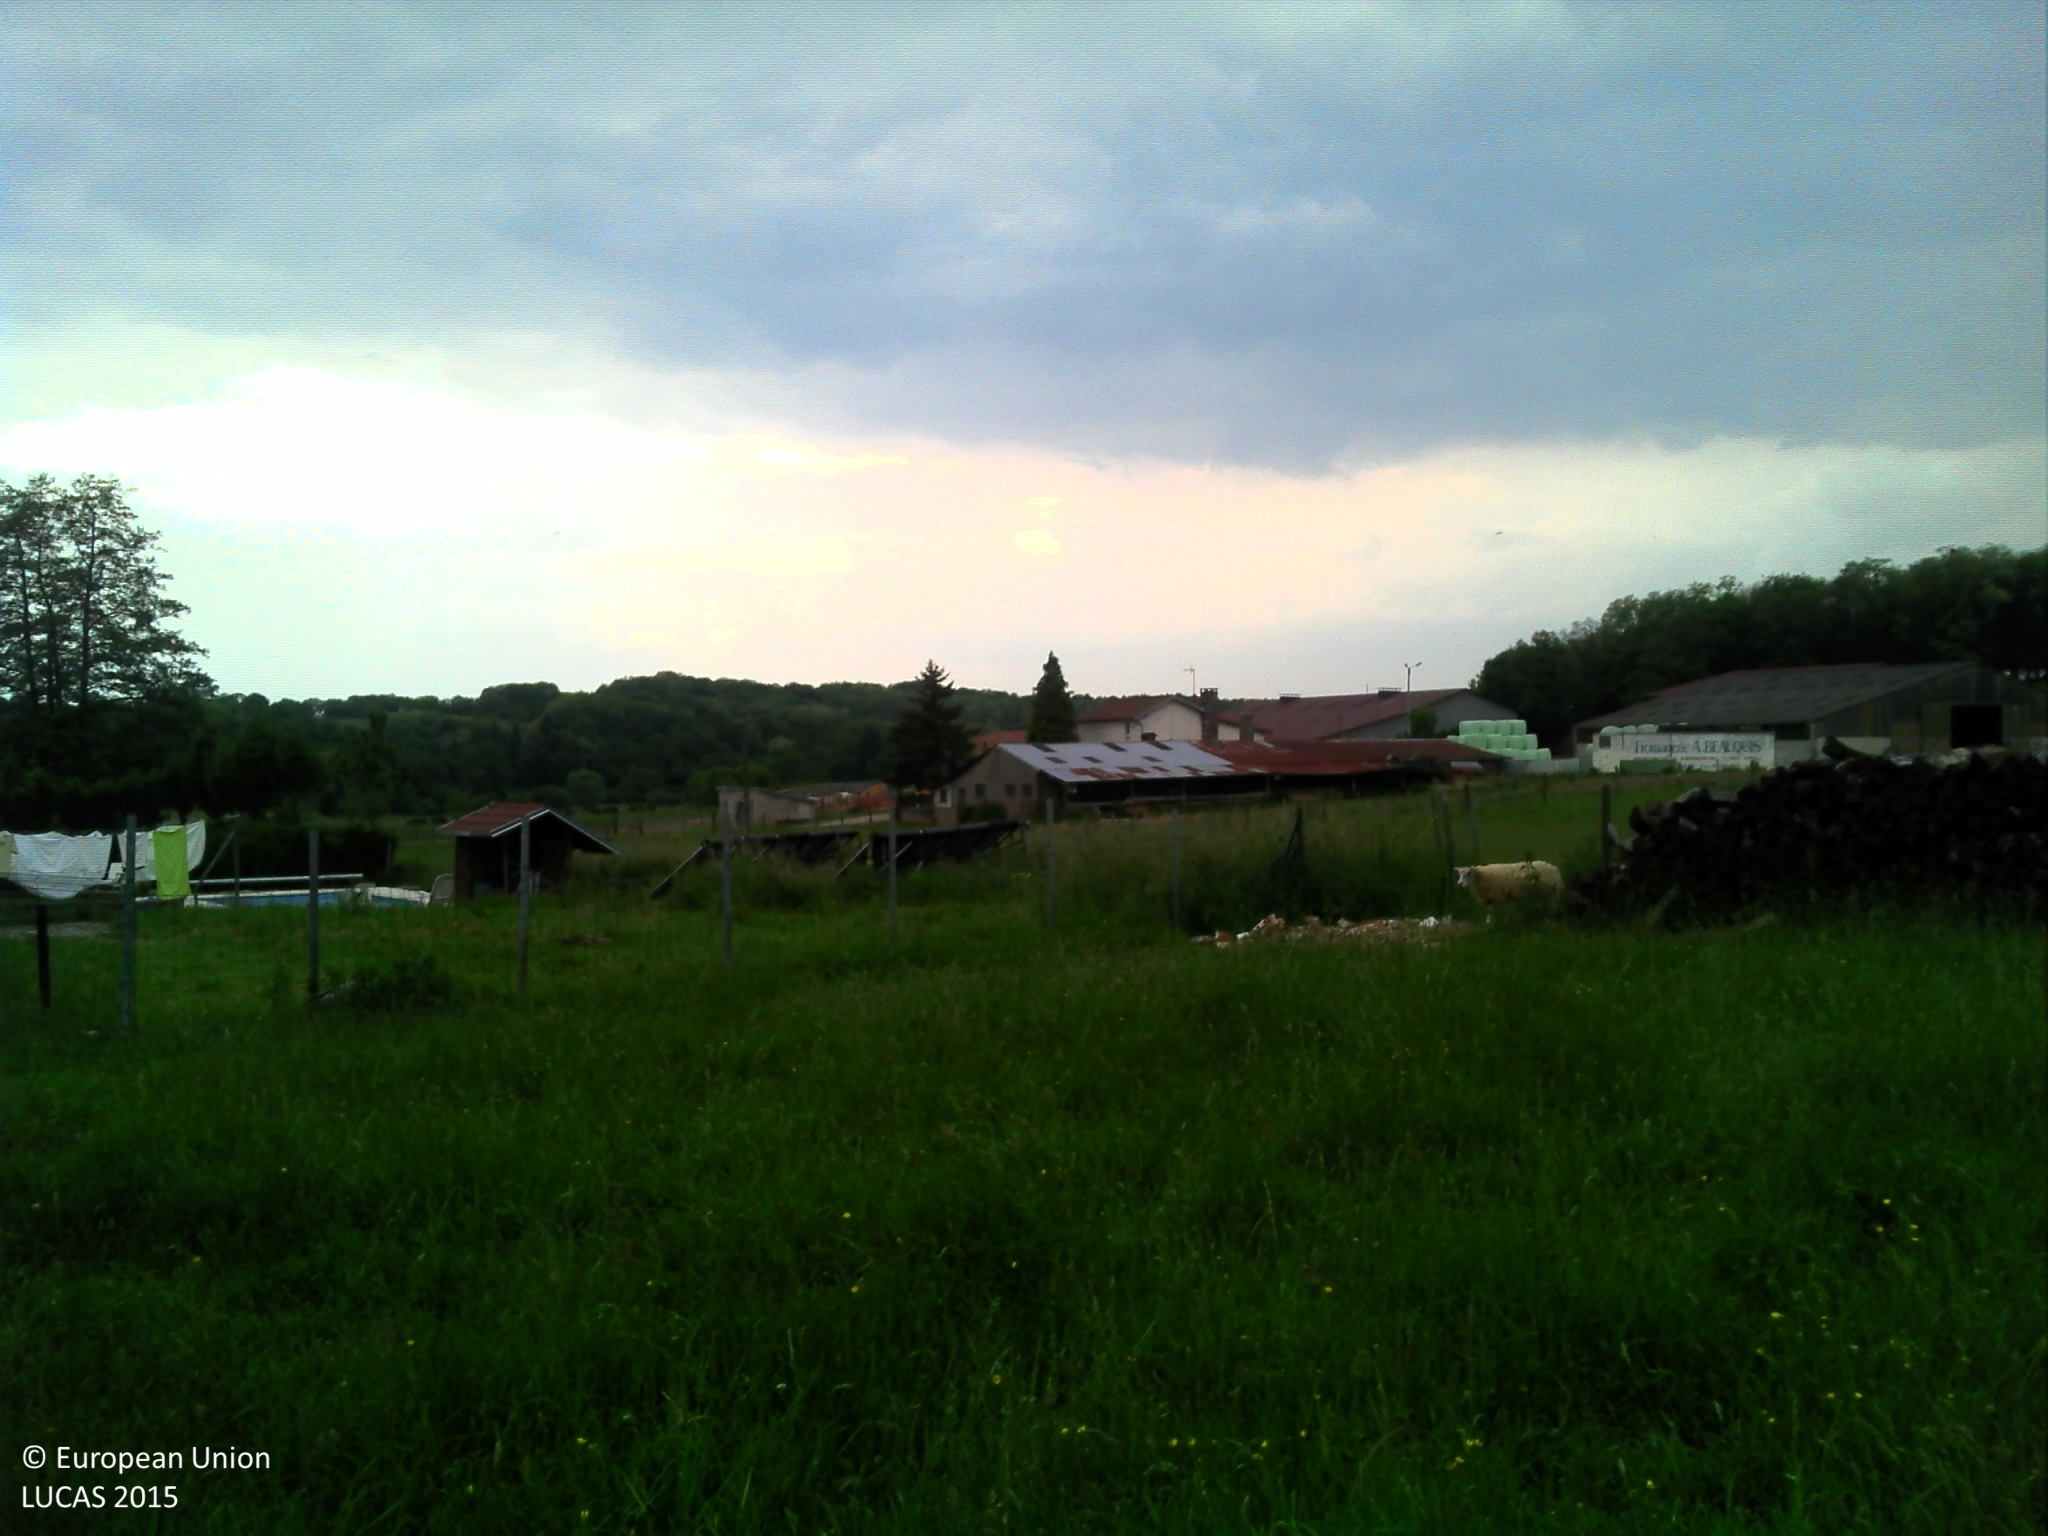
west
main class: Grassland
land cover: Grassland without tree/shrub cover
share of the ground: > 75 %
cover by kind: herbaceous plants 100 %
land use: Agriculture (excluding fallow land and kitchen gardens)
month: May
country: FR
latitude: 47.9216
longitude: 6.1333
